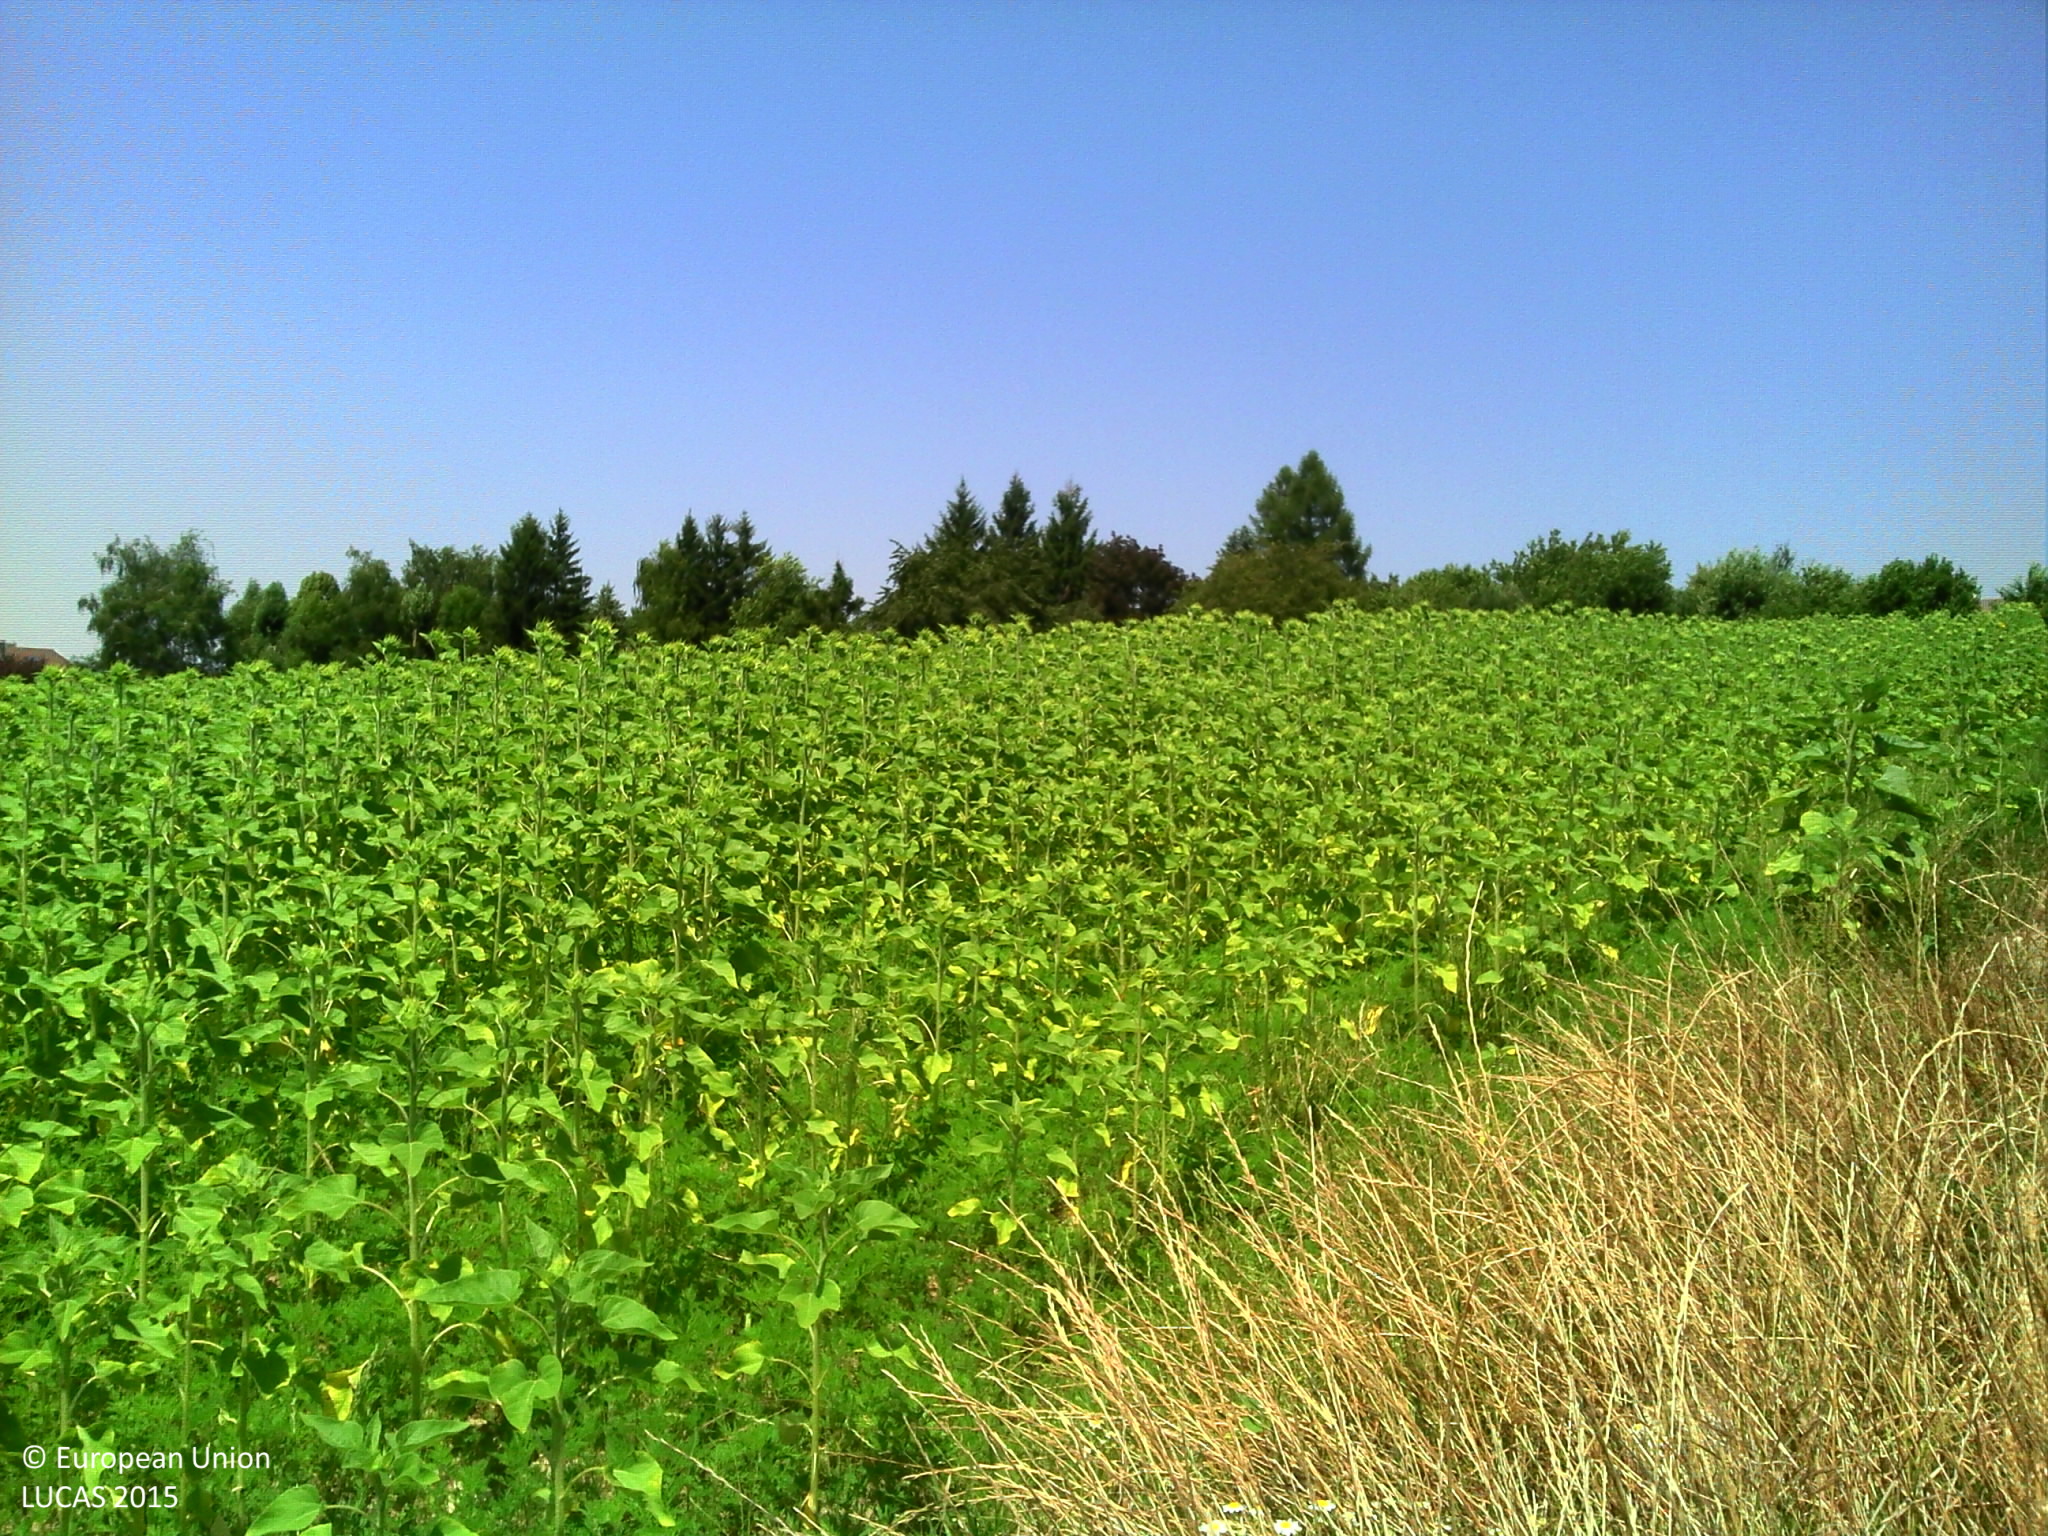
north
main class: Cropland
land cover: Durum wheat
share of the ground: > 75 %
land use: Agriculture (excluding fallow land and kitchen gardens)
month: July
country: FR
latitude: 45.6556
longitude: 5.3715
